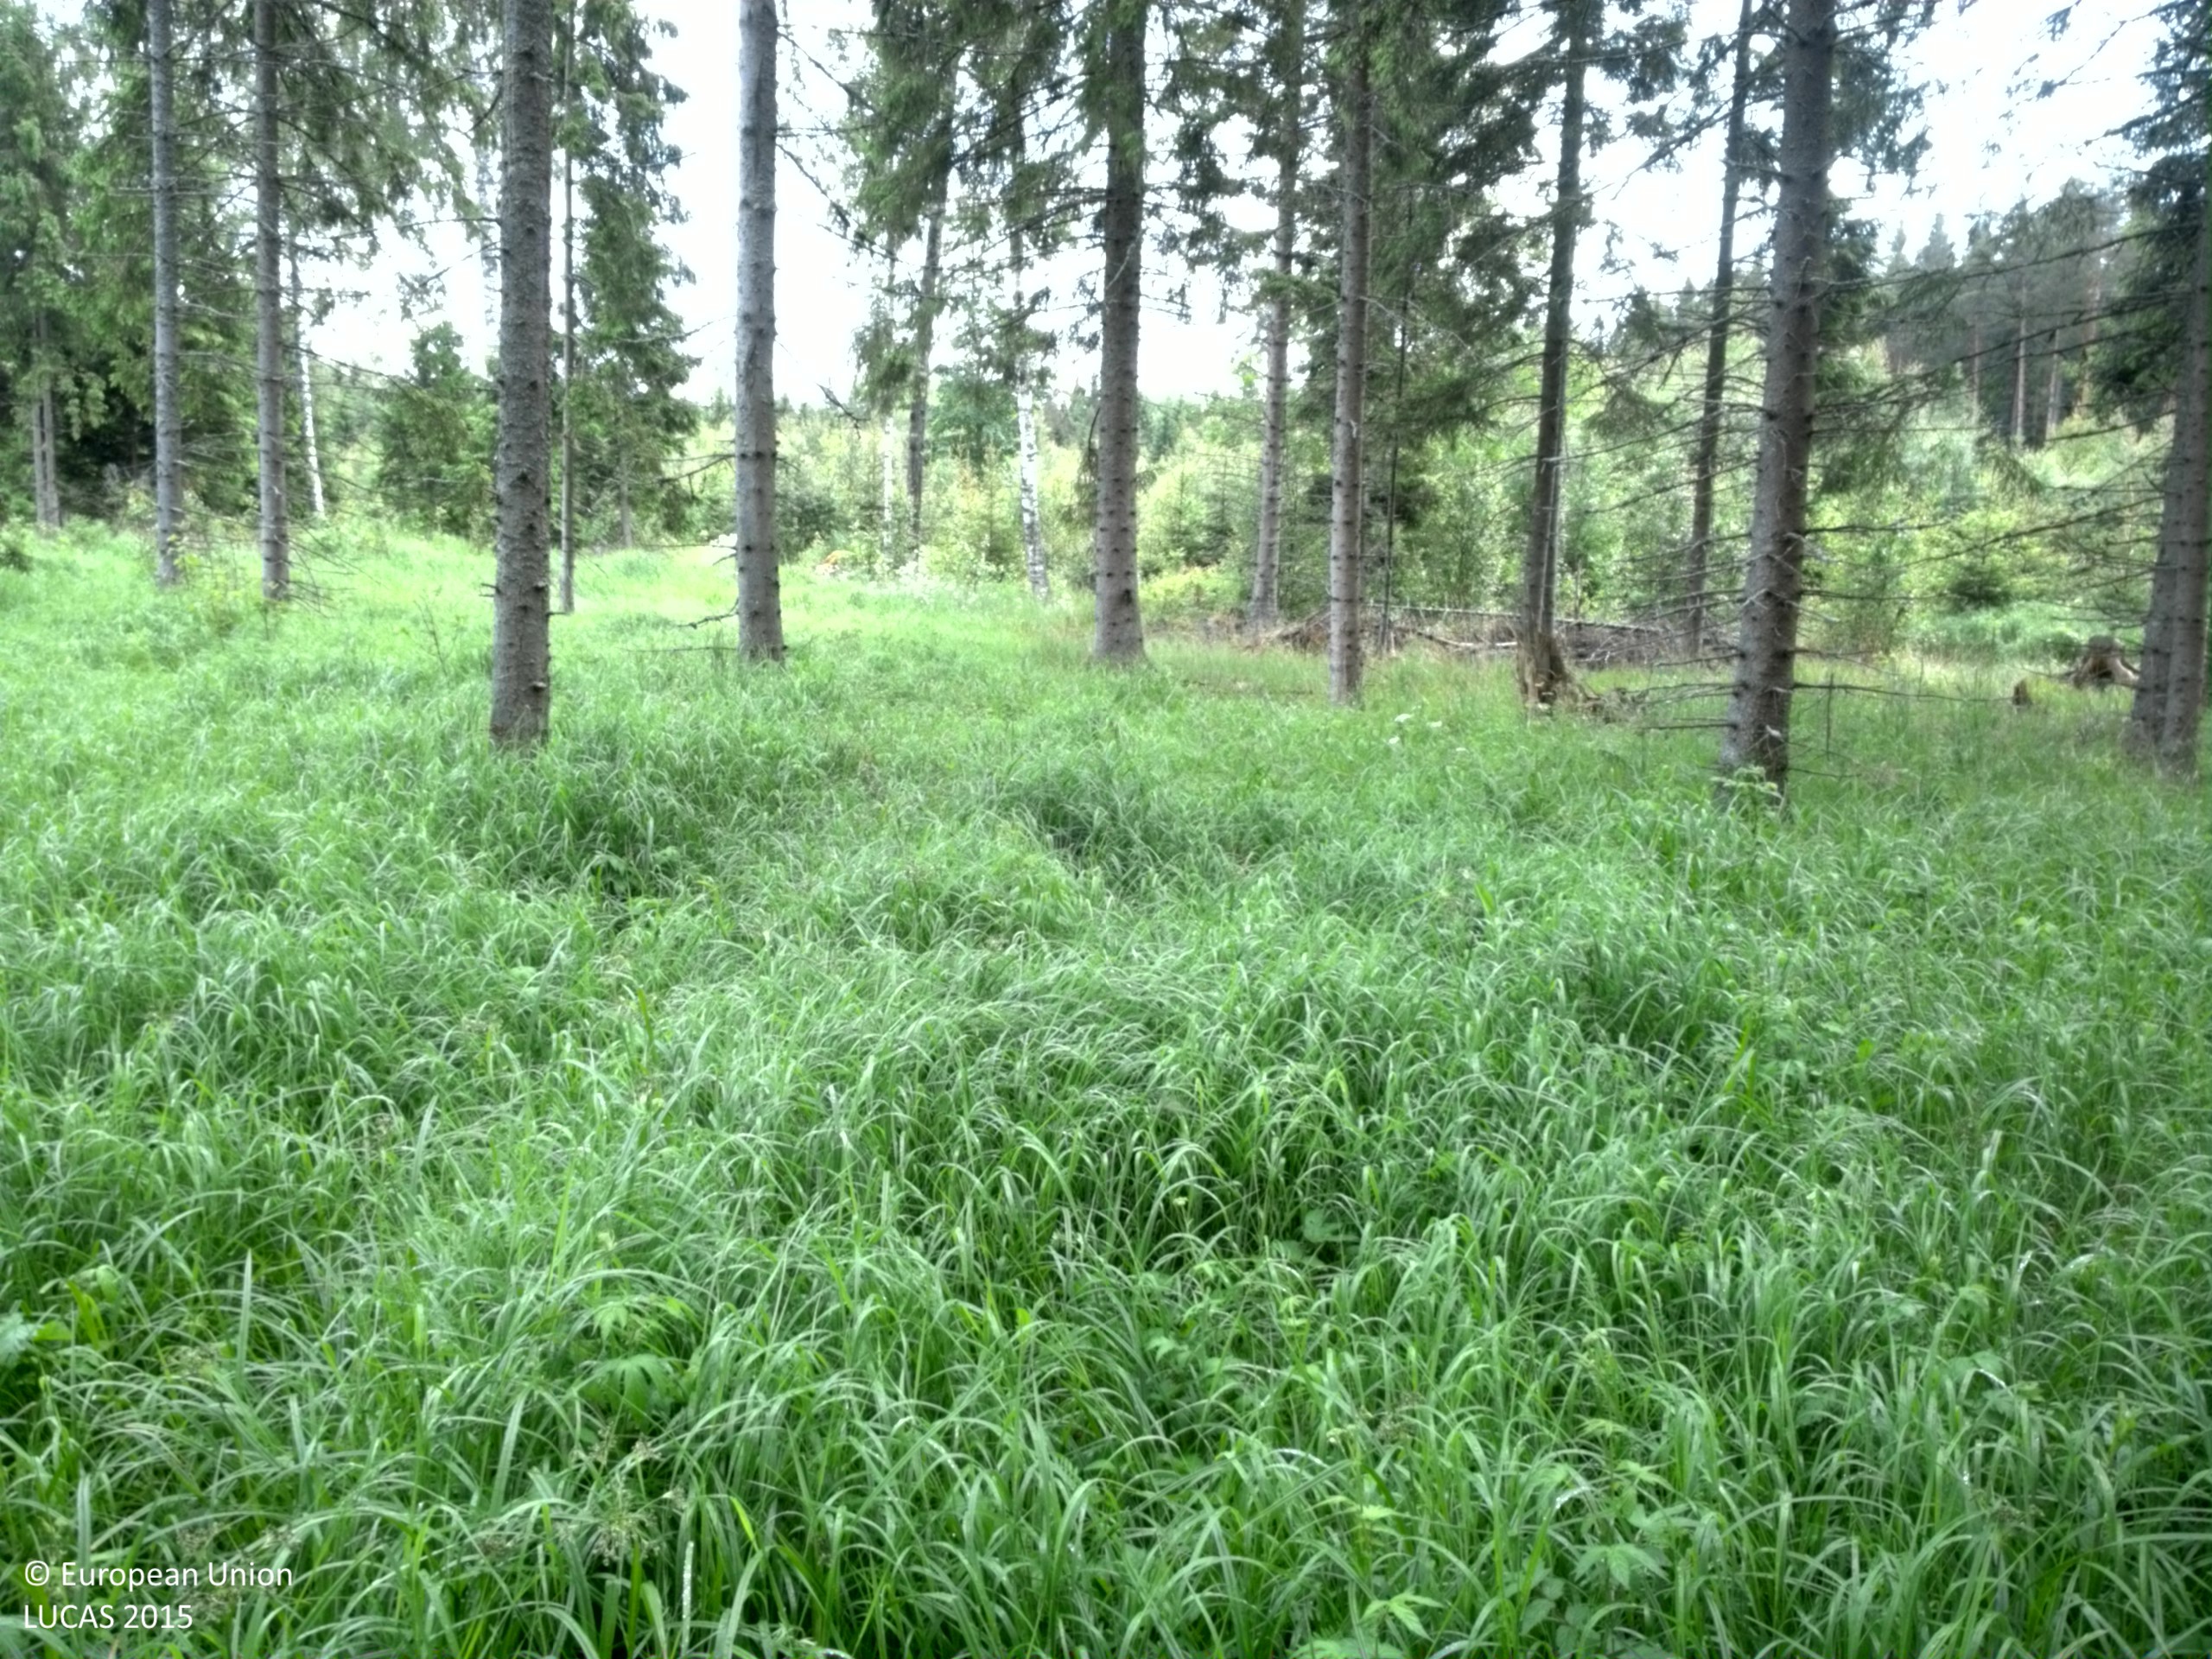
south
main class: Woodland
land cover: Spruce dominated coniferous woodland
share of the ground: 25 - 50 %
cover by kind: herbaceous plants 50 %, coniferous forest trees 40 %, lichens and mosses 5 %, consolidated bare surface 5 %
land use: Forestry
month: June
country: SE
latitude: 60.3307
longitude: 17.7260
